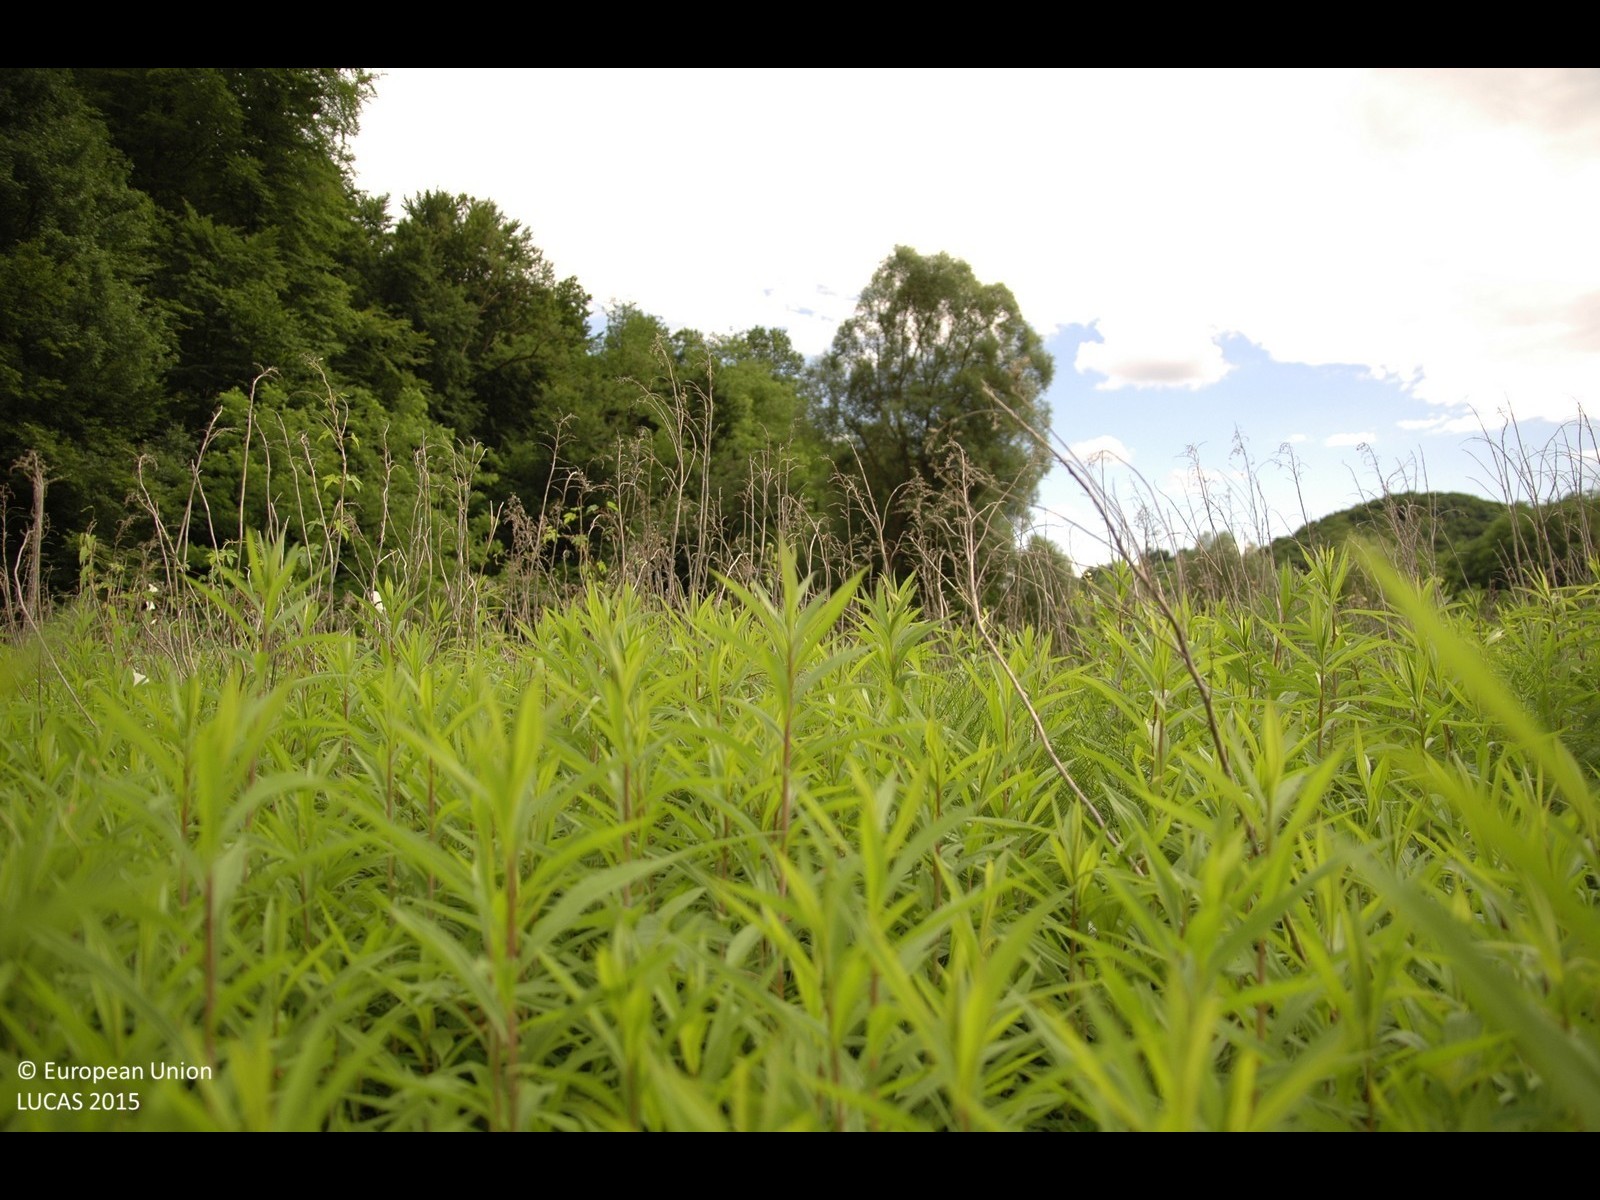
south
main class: Shrubland
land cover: Shrubland without tree cover
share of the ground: > 75 %
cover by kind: shrubs 90 %, herbaceous plants 10 %
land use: Fallow land
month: June
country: HR
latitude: 46.0630
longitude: 15.8802
